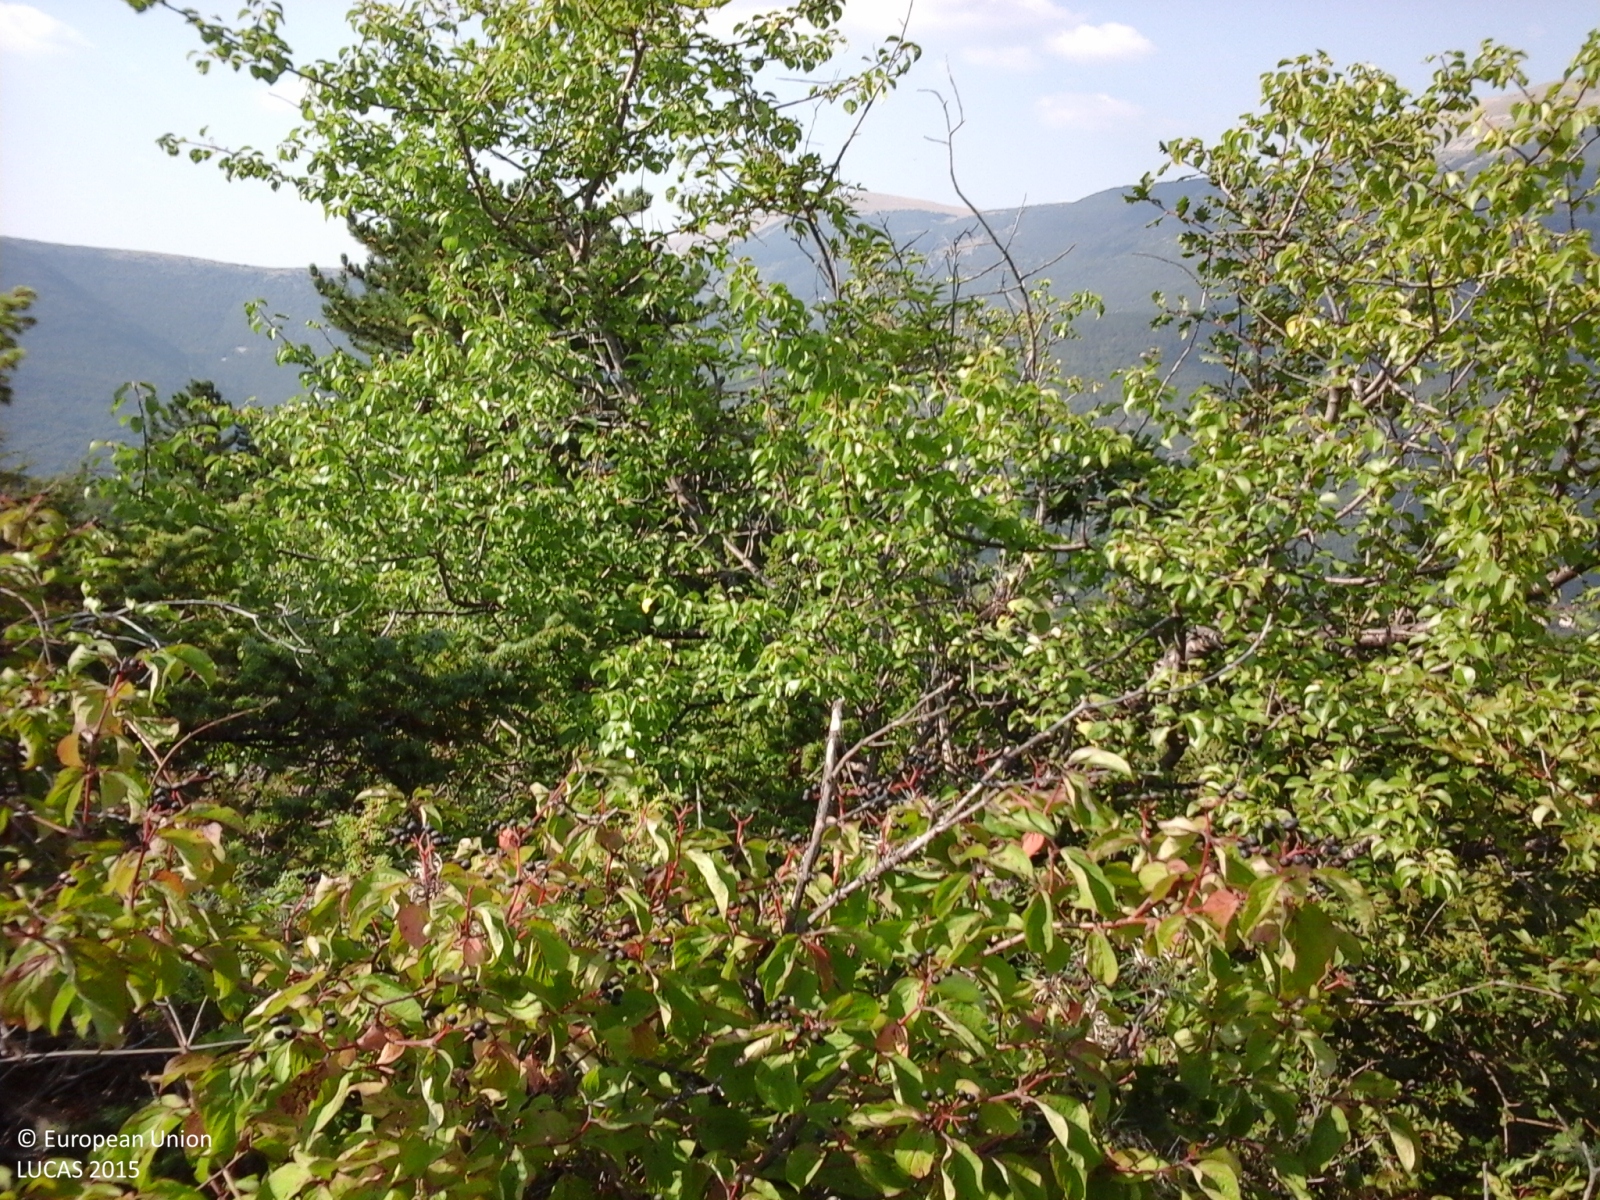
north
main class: Shrubland
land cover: Shrubland with sparse tree cover
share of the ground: > 75 %
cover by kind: shrubs 70 %, herbaceous plants 25 %, coniferous forest trees 5 %
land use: Agriculture (excluding fallow land and kitchen gardens)
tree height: < 5 m
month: August
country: IT
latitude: 42.9306
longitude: 13.1400
